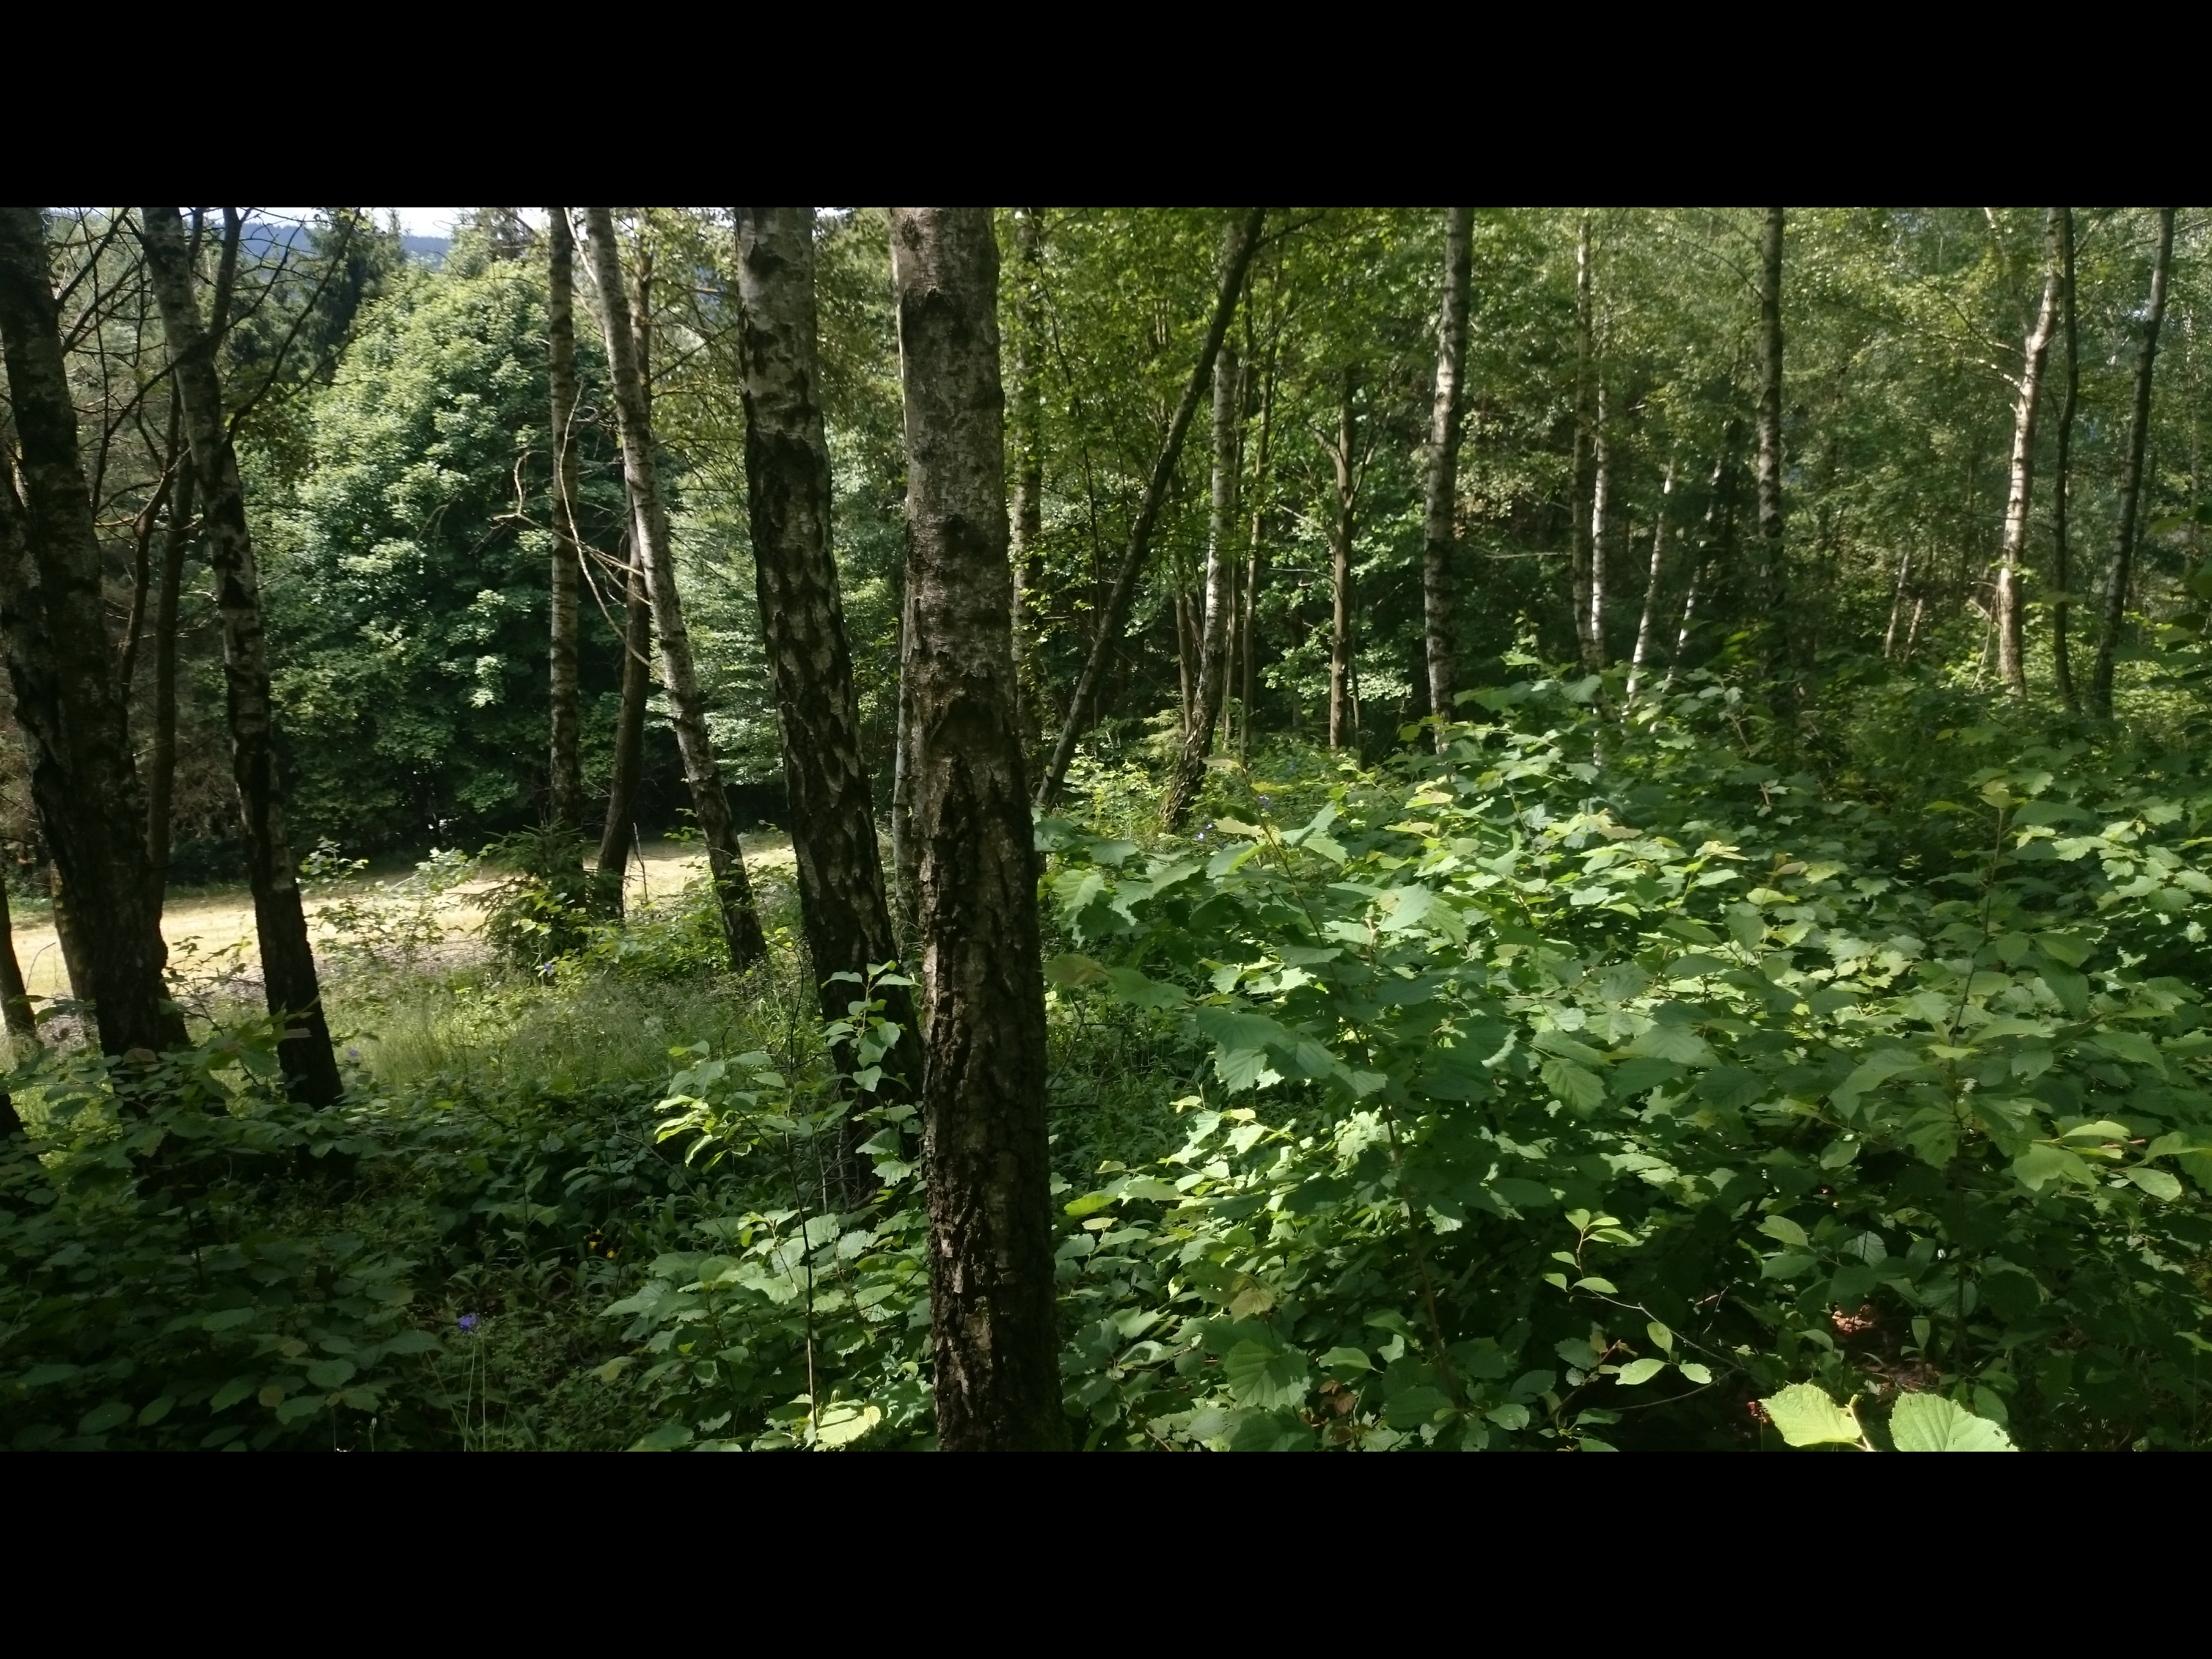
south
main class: Woodland
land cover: Broadleaved woodland
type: non-riverine alder, birch or aspen forest
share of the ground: > 75 %
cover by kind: broadleaved forest trees 80 %, shrubs 10 %, herbaceous plants 10 %
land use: Forestry
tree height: > 5 m
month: June
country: AT
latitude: 48.6421
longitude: 14.7922
